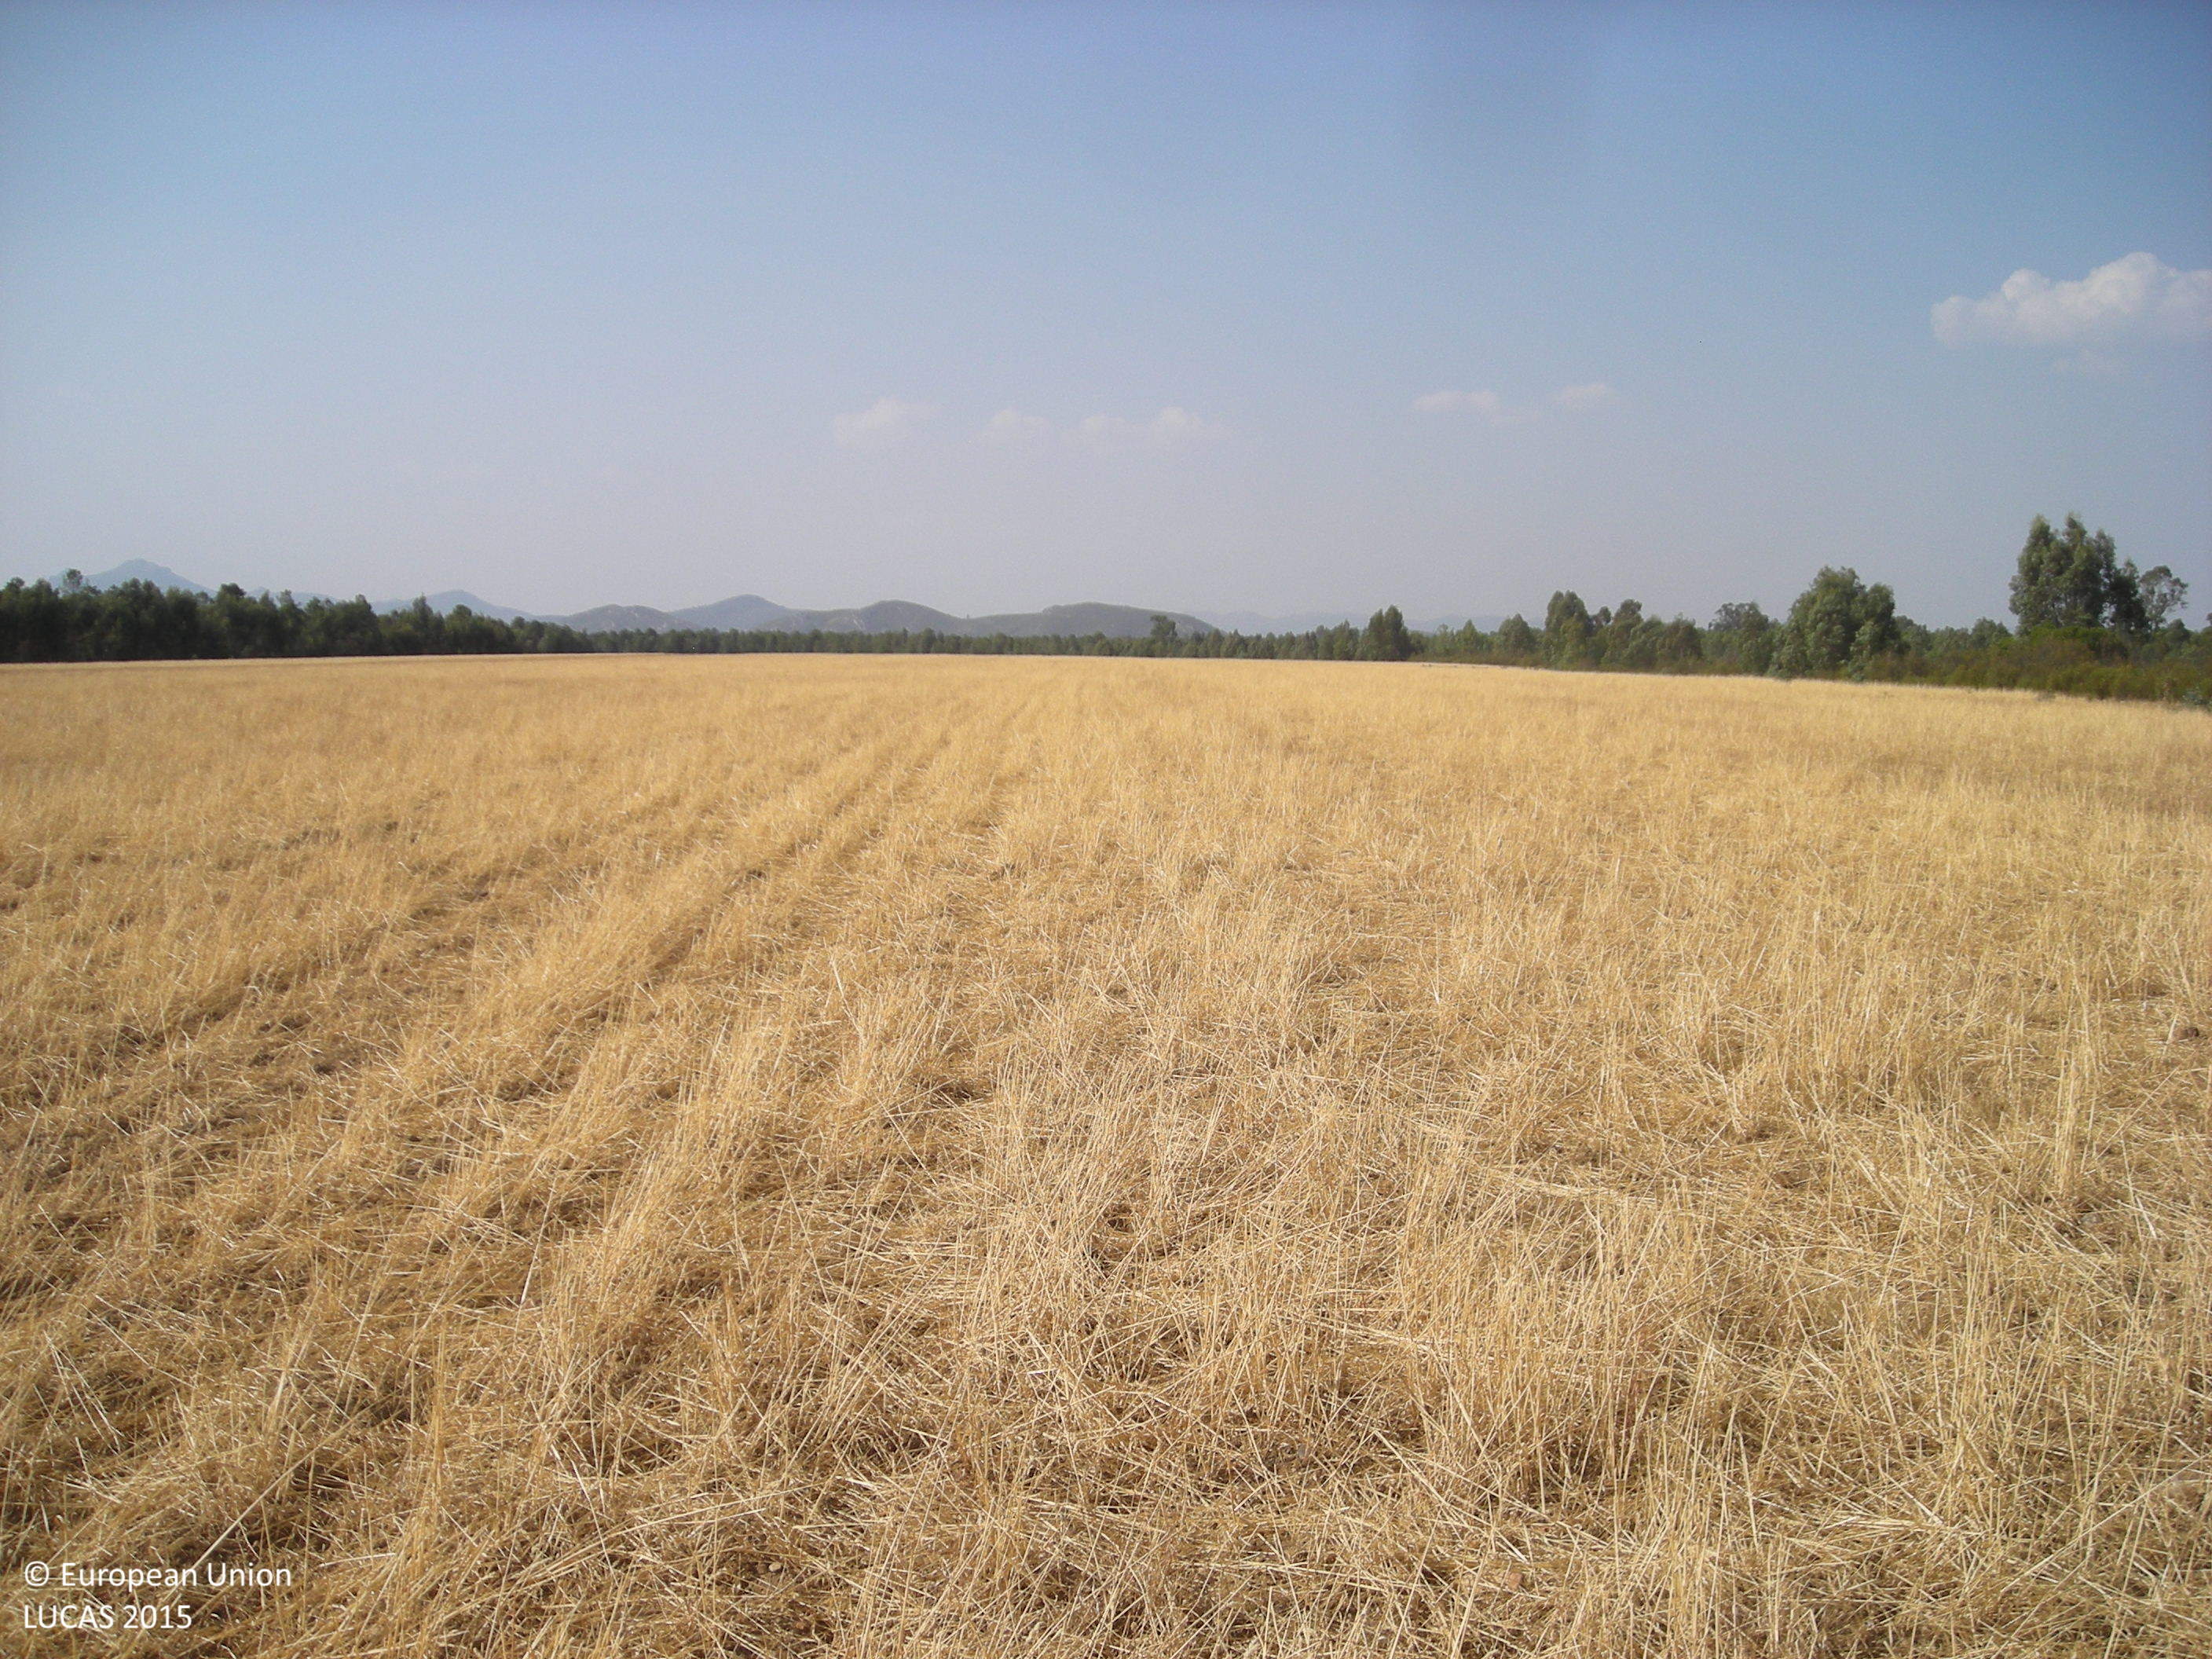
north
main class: Grassland
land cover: Grassland without tree/shrub cover
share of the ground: > 75 %
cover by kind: herbaceous plants 100 %
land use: Agriculture (excluding fallow land and kitchen gardens)
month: July
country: ES
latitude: 39.3097
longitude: -5.3431
